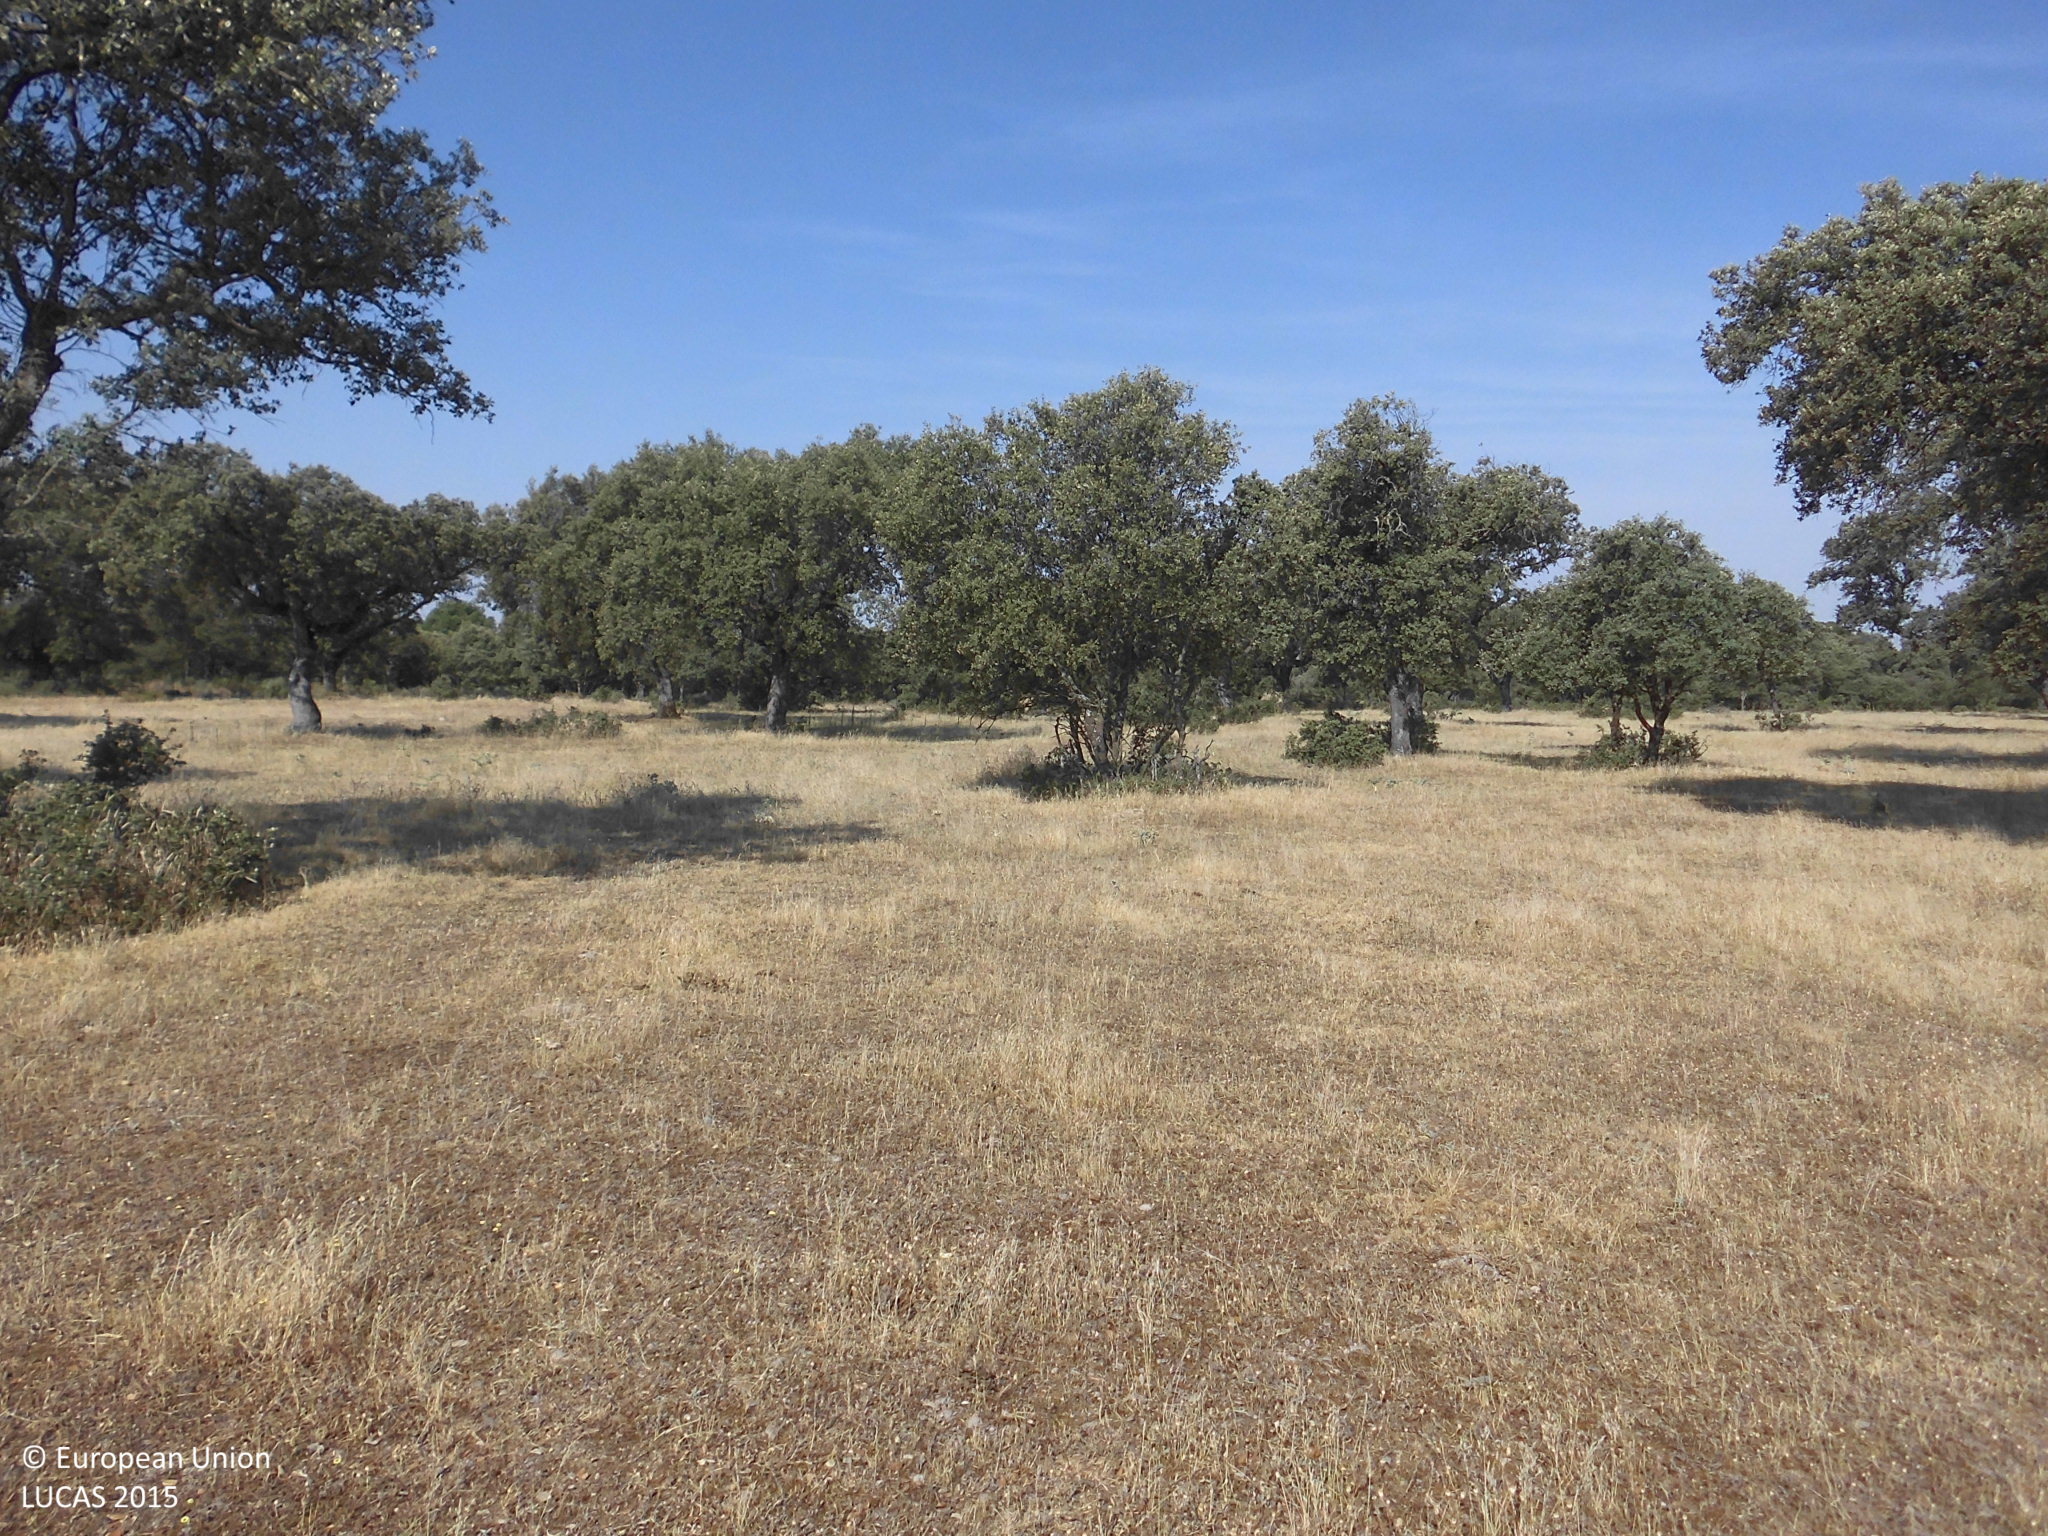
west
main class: Woodland
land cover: Broadleaved woodland
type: broadleaved evergreen forest
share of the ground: 10 - 25 %
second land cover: Grassland without tree/shrub cover
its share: > 75 %
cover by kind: herbaceous plants 85 %, broadleaved forest trees 15 %
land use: Forestry
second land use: Agriculture (excluding fallow land and kitchen gardens)
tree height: > 5 m
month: June
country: ES
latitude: 39.9468
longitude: -5.4967
